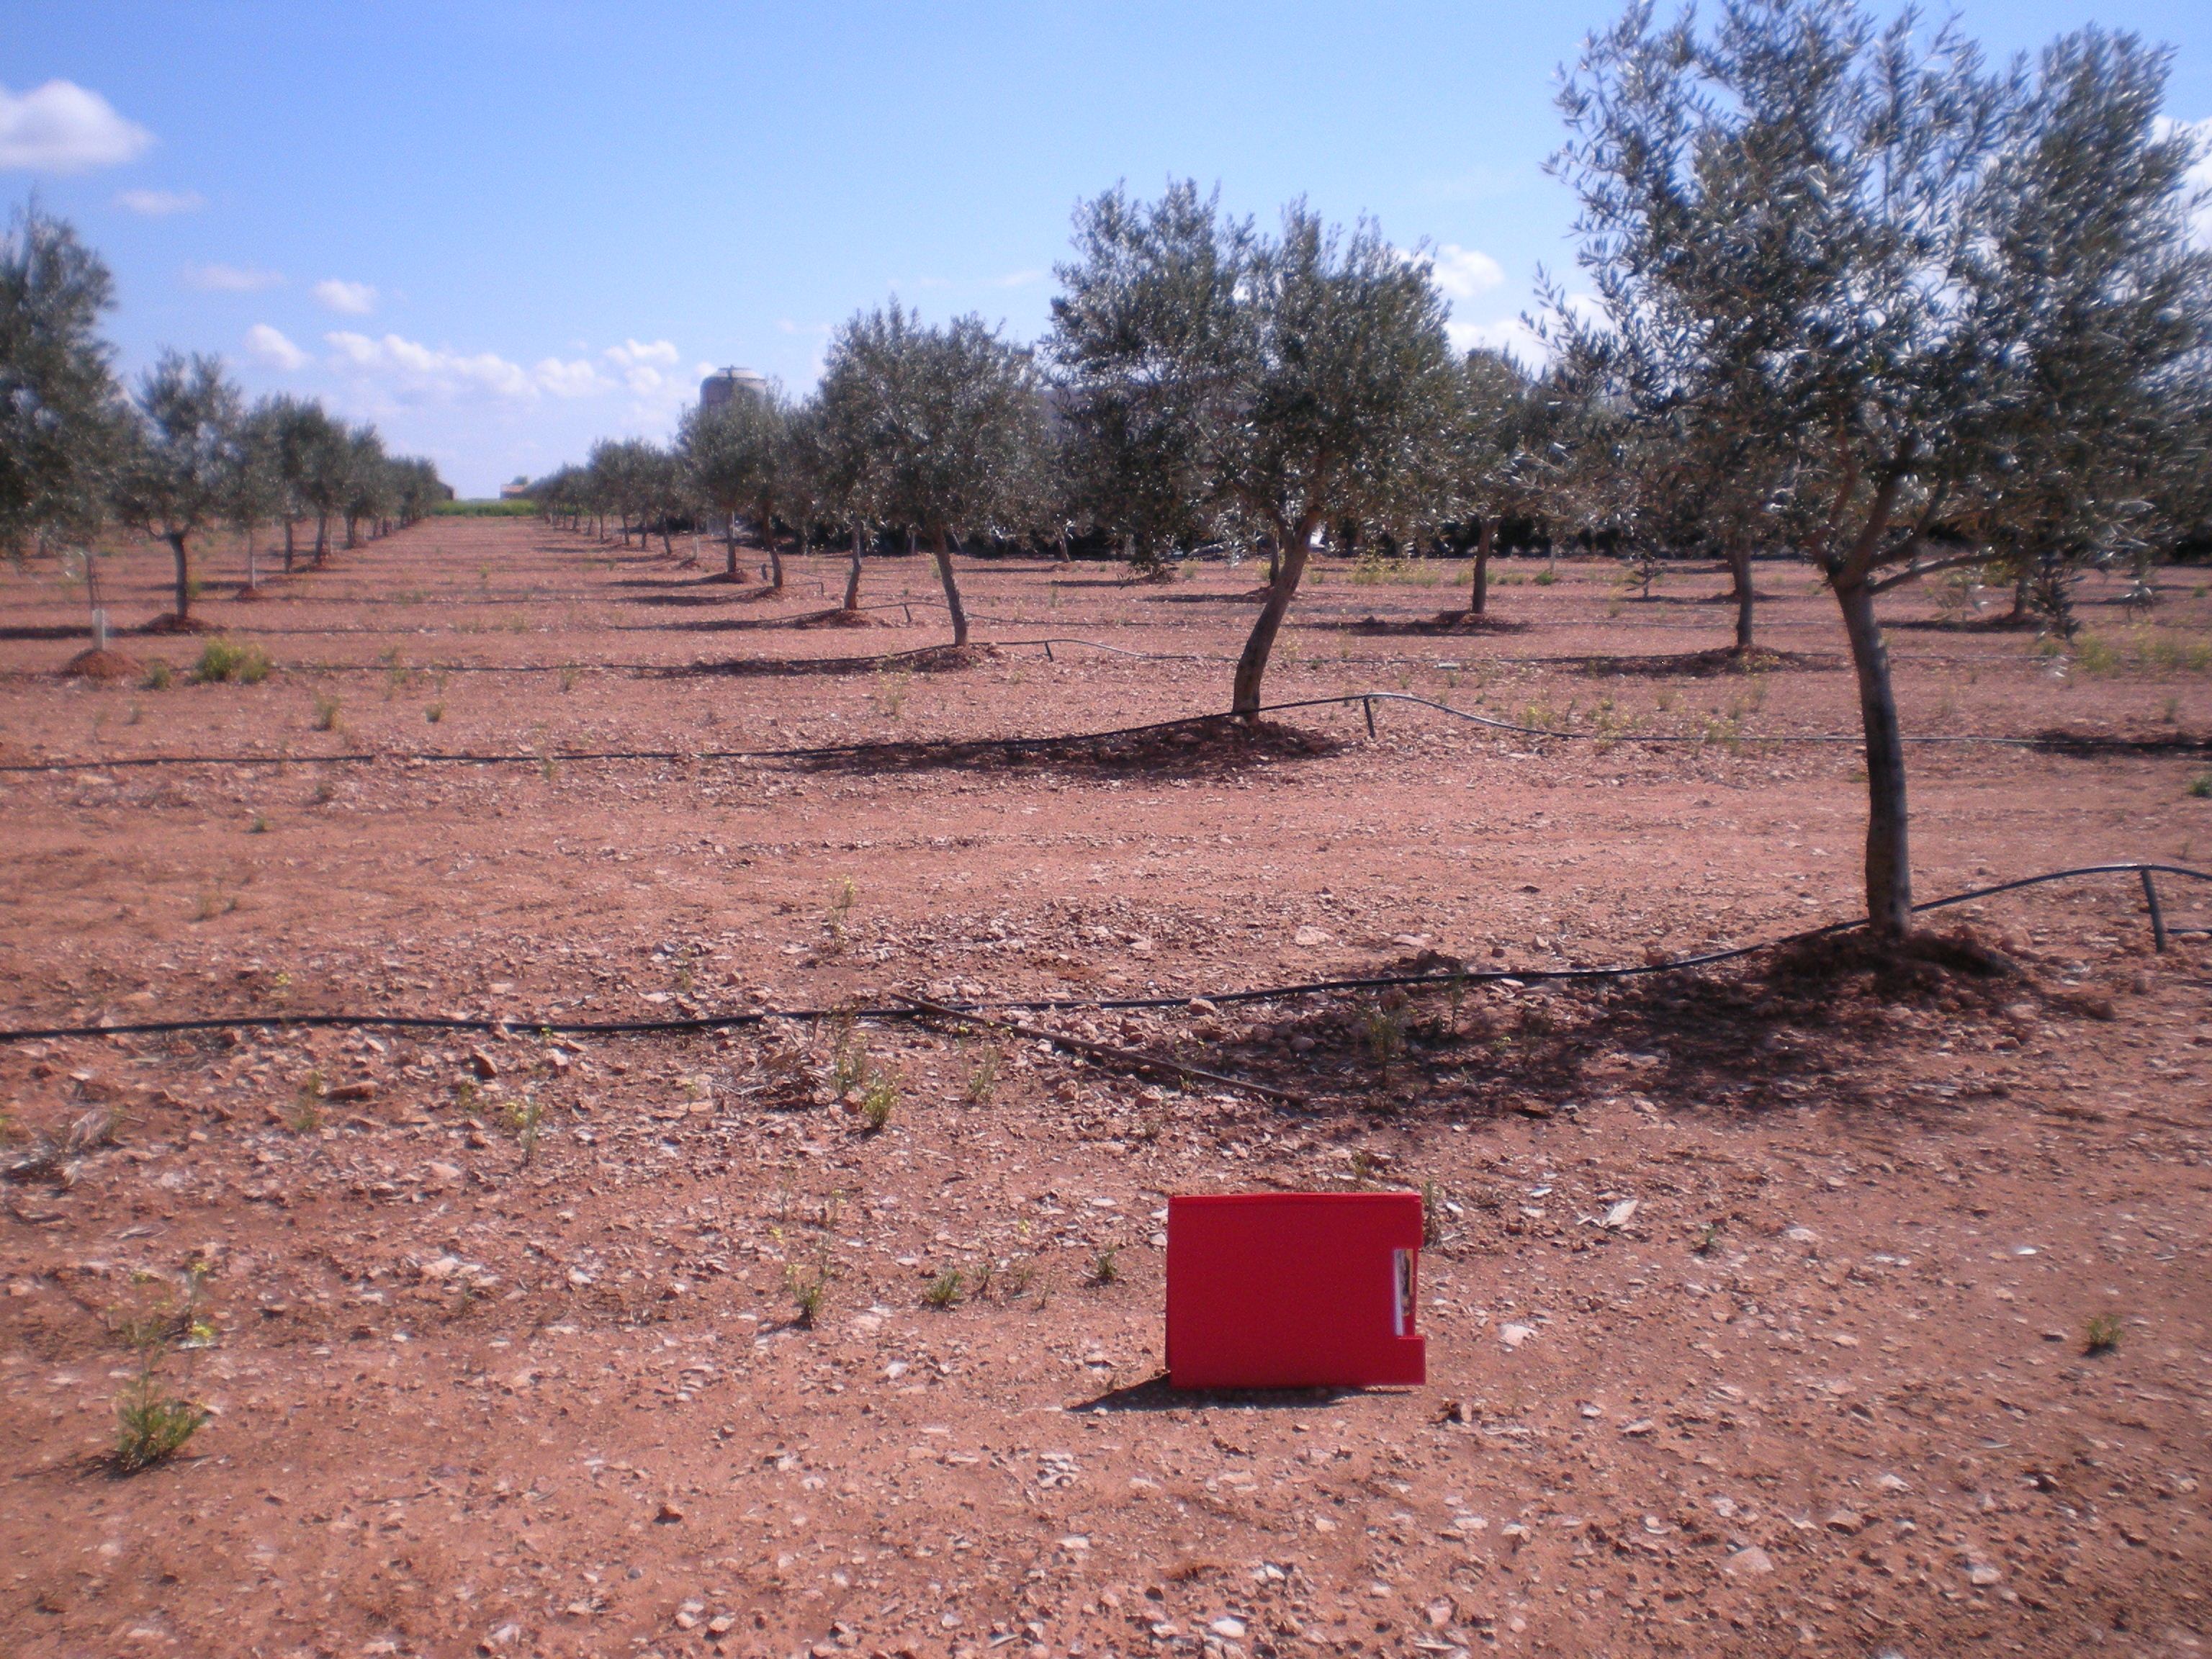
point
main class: Cropland
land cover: Olive groves
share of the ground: < 10 %
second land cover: Other bare soil
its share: > 75 %
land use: Agriculture (excluding fallow land and kitchen gardens)
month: April
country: ES
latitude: 38.9494
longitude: -3.5968
